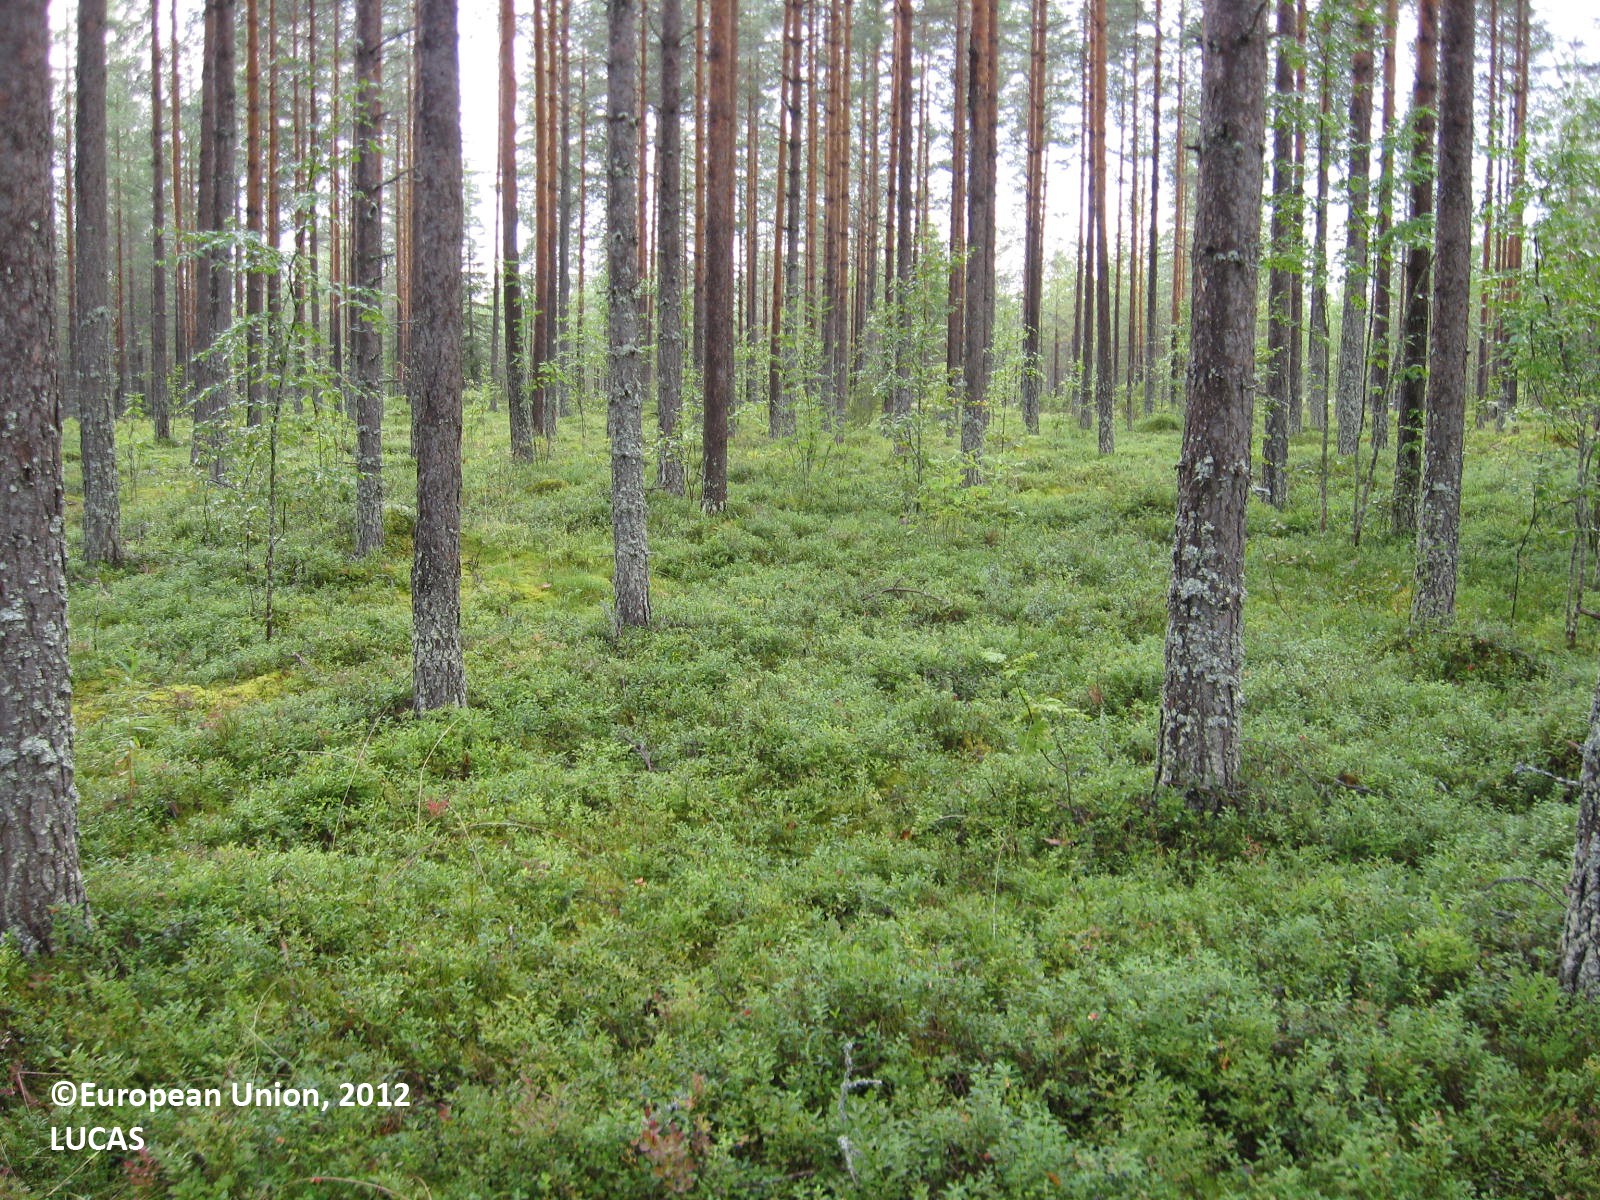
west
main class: Woodland
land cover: Pine dominated coniferous woodland
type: boreal forest
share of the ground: > 75 %
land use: Forestry
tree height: > 5 m
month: August
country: FI
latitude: 63.4404
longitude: 30.4130
